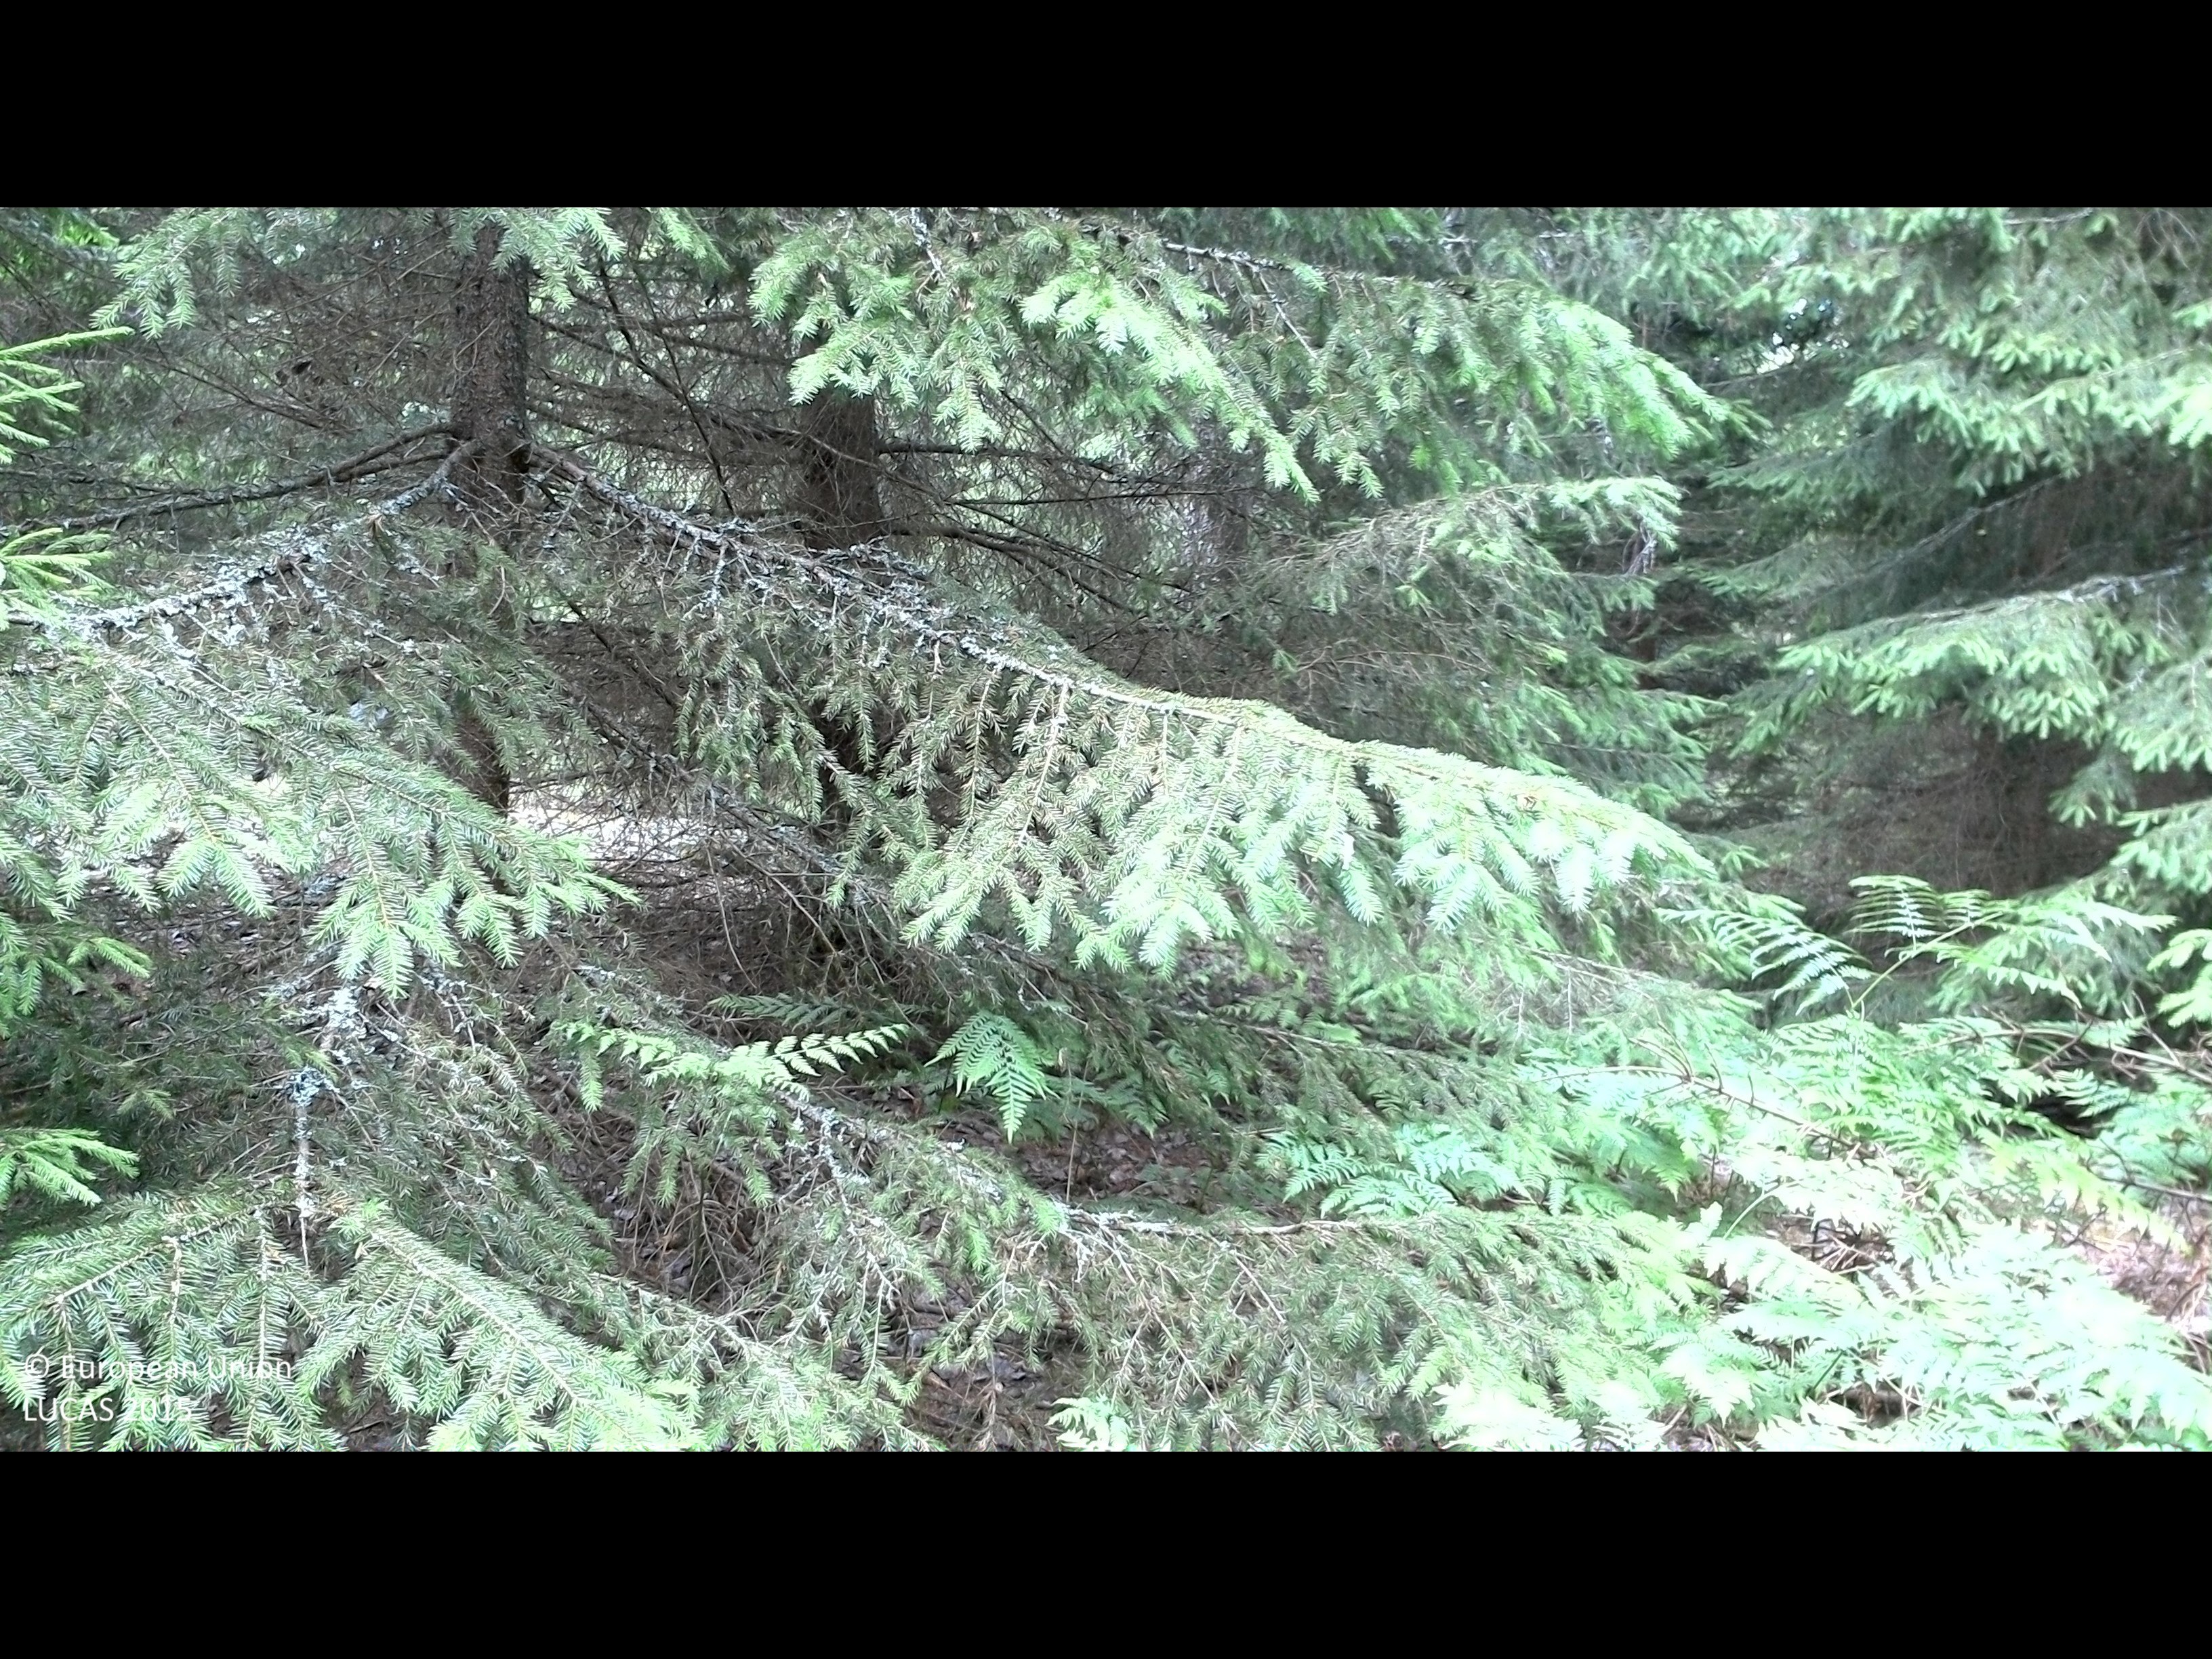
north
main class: Woodland
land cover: Spruce dominated coniferous woodland
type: boreal forest
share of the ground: > 75 %
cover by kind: coniferous forest trees 70 %, herbaceous plants 15 %, broadleaved forest trees 5 %, shrubs 5 %, lichens and mosses 5 %
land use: Forestry
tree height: > 5 m
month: July
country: SE
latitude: 56.4768
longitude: 14.7873
